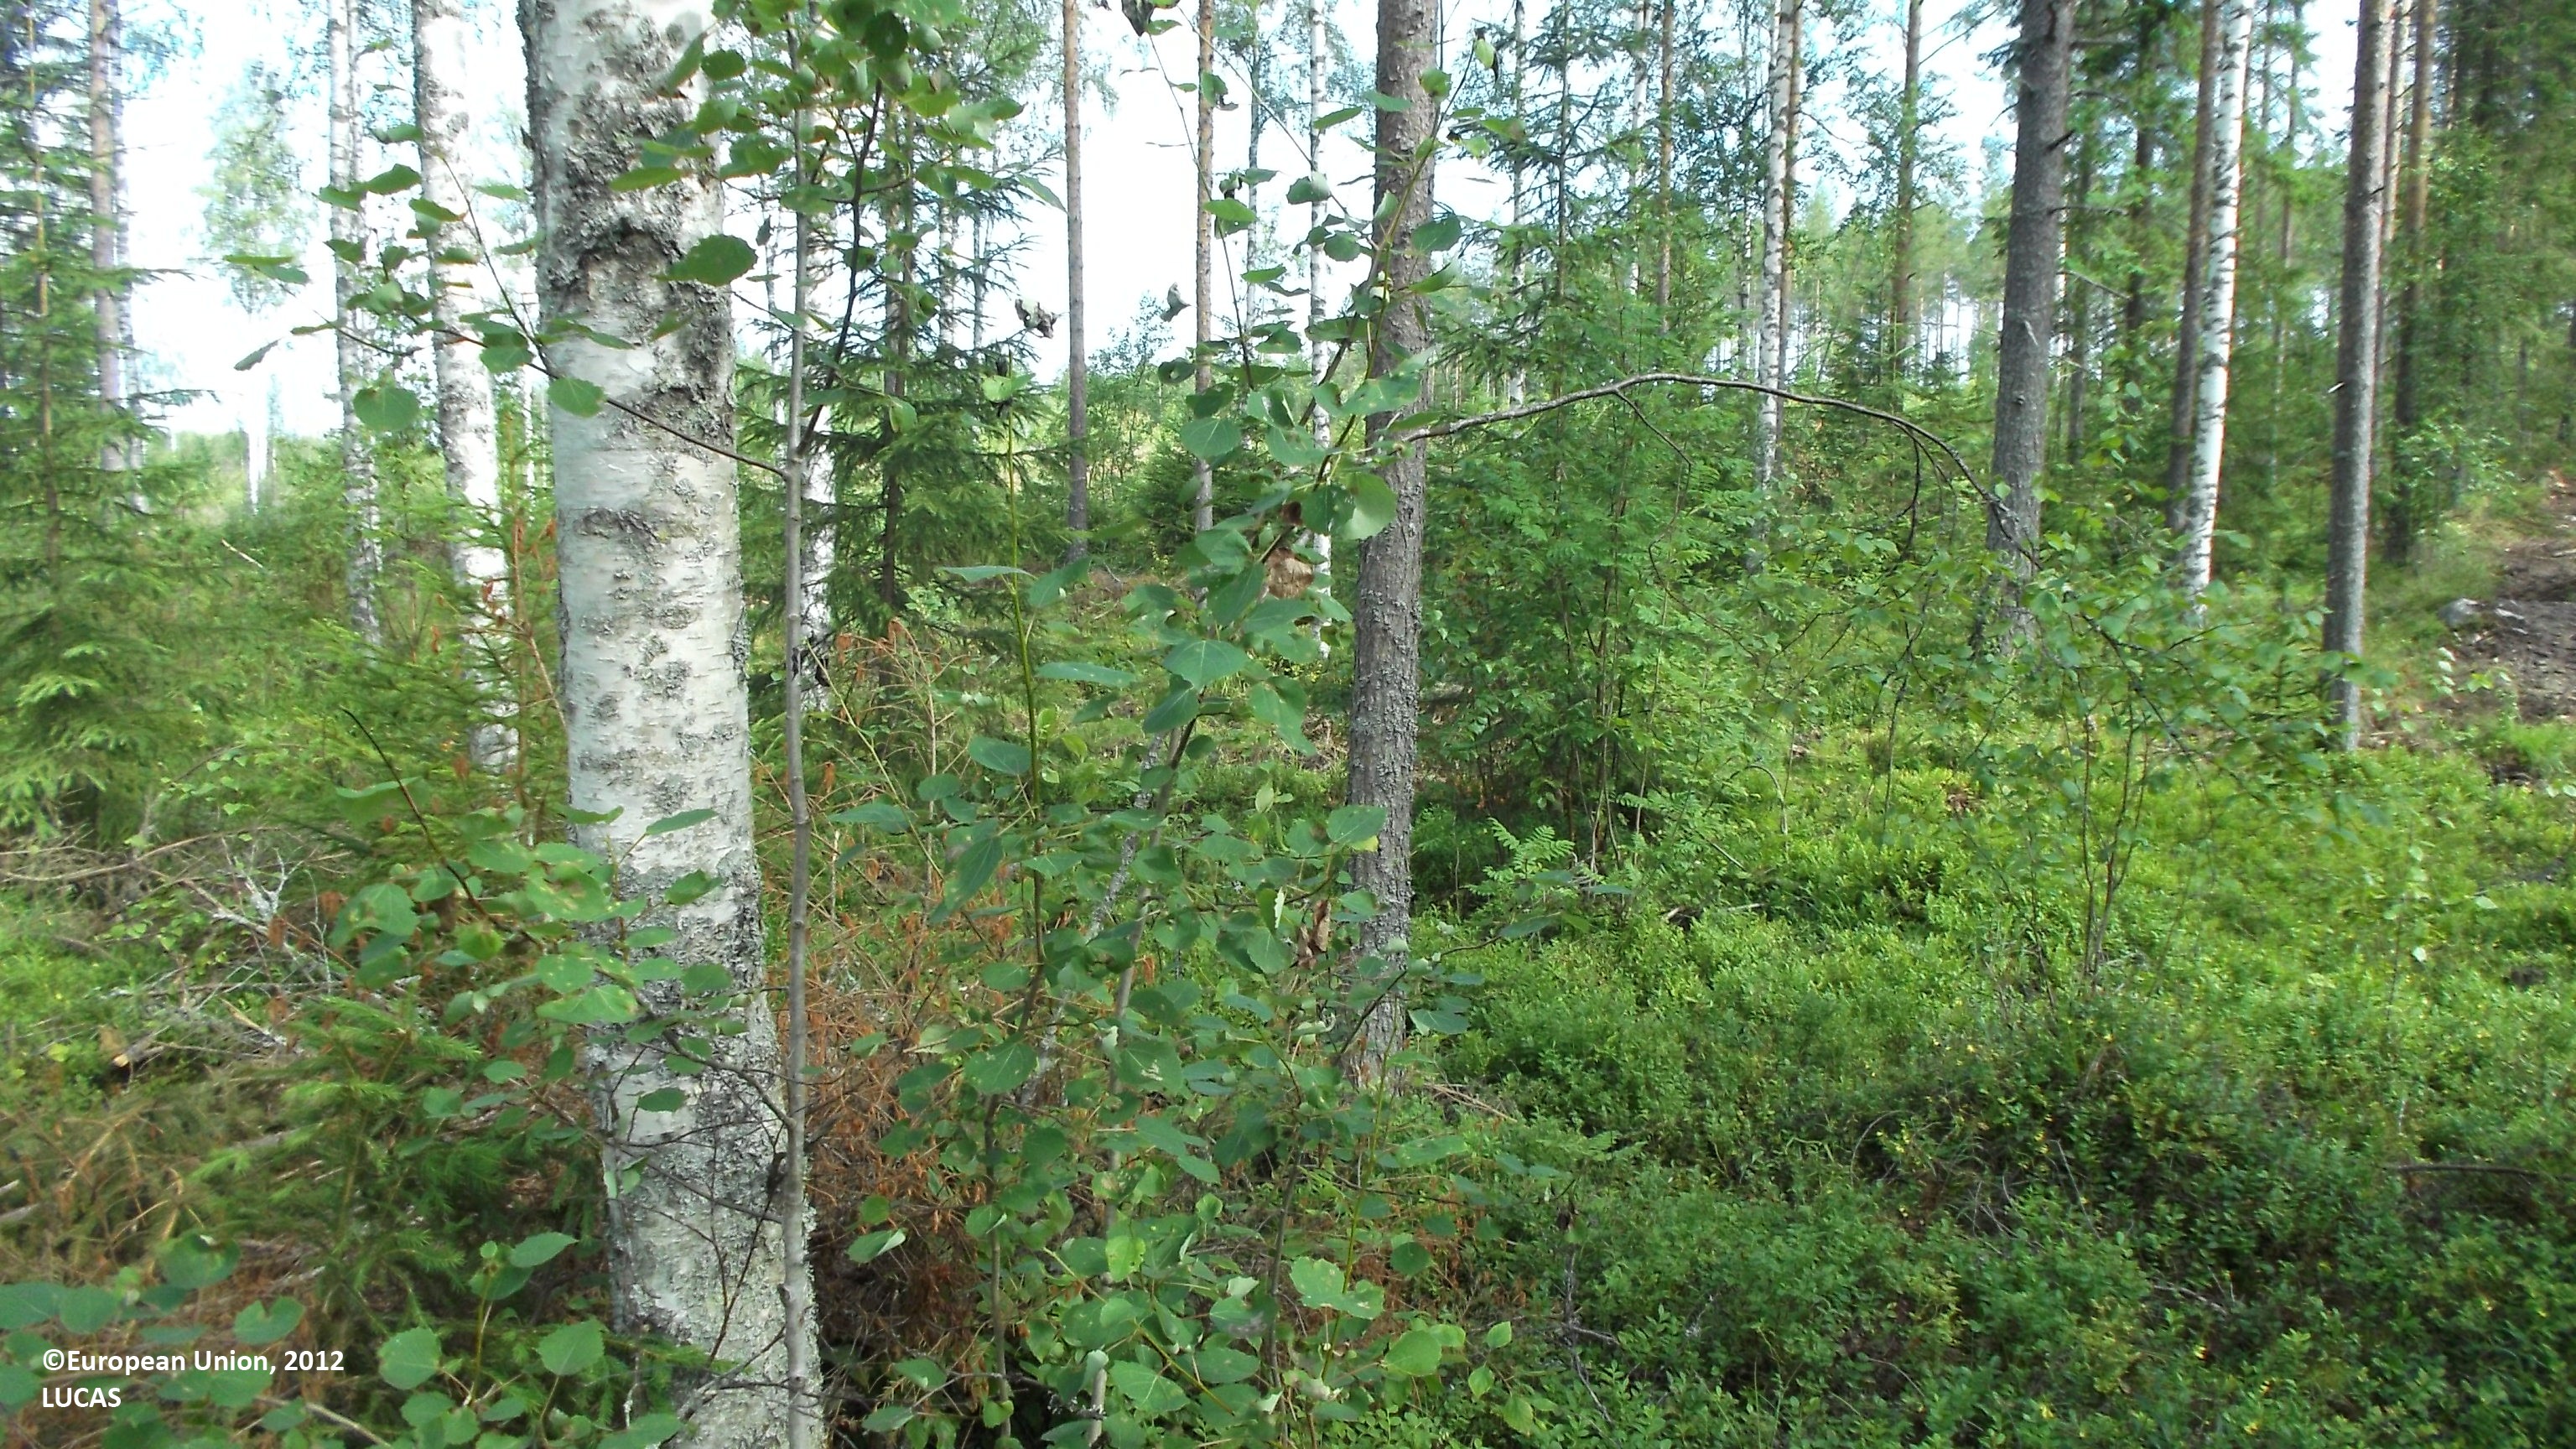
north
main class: Woodland
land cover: Other mixed woodland
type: boreal forest
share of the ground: 25 - 50 %
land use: Forestry
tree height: > 5 m
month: July
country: FI
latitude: 63.4880
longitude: 23.6993
